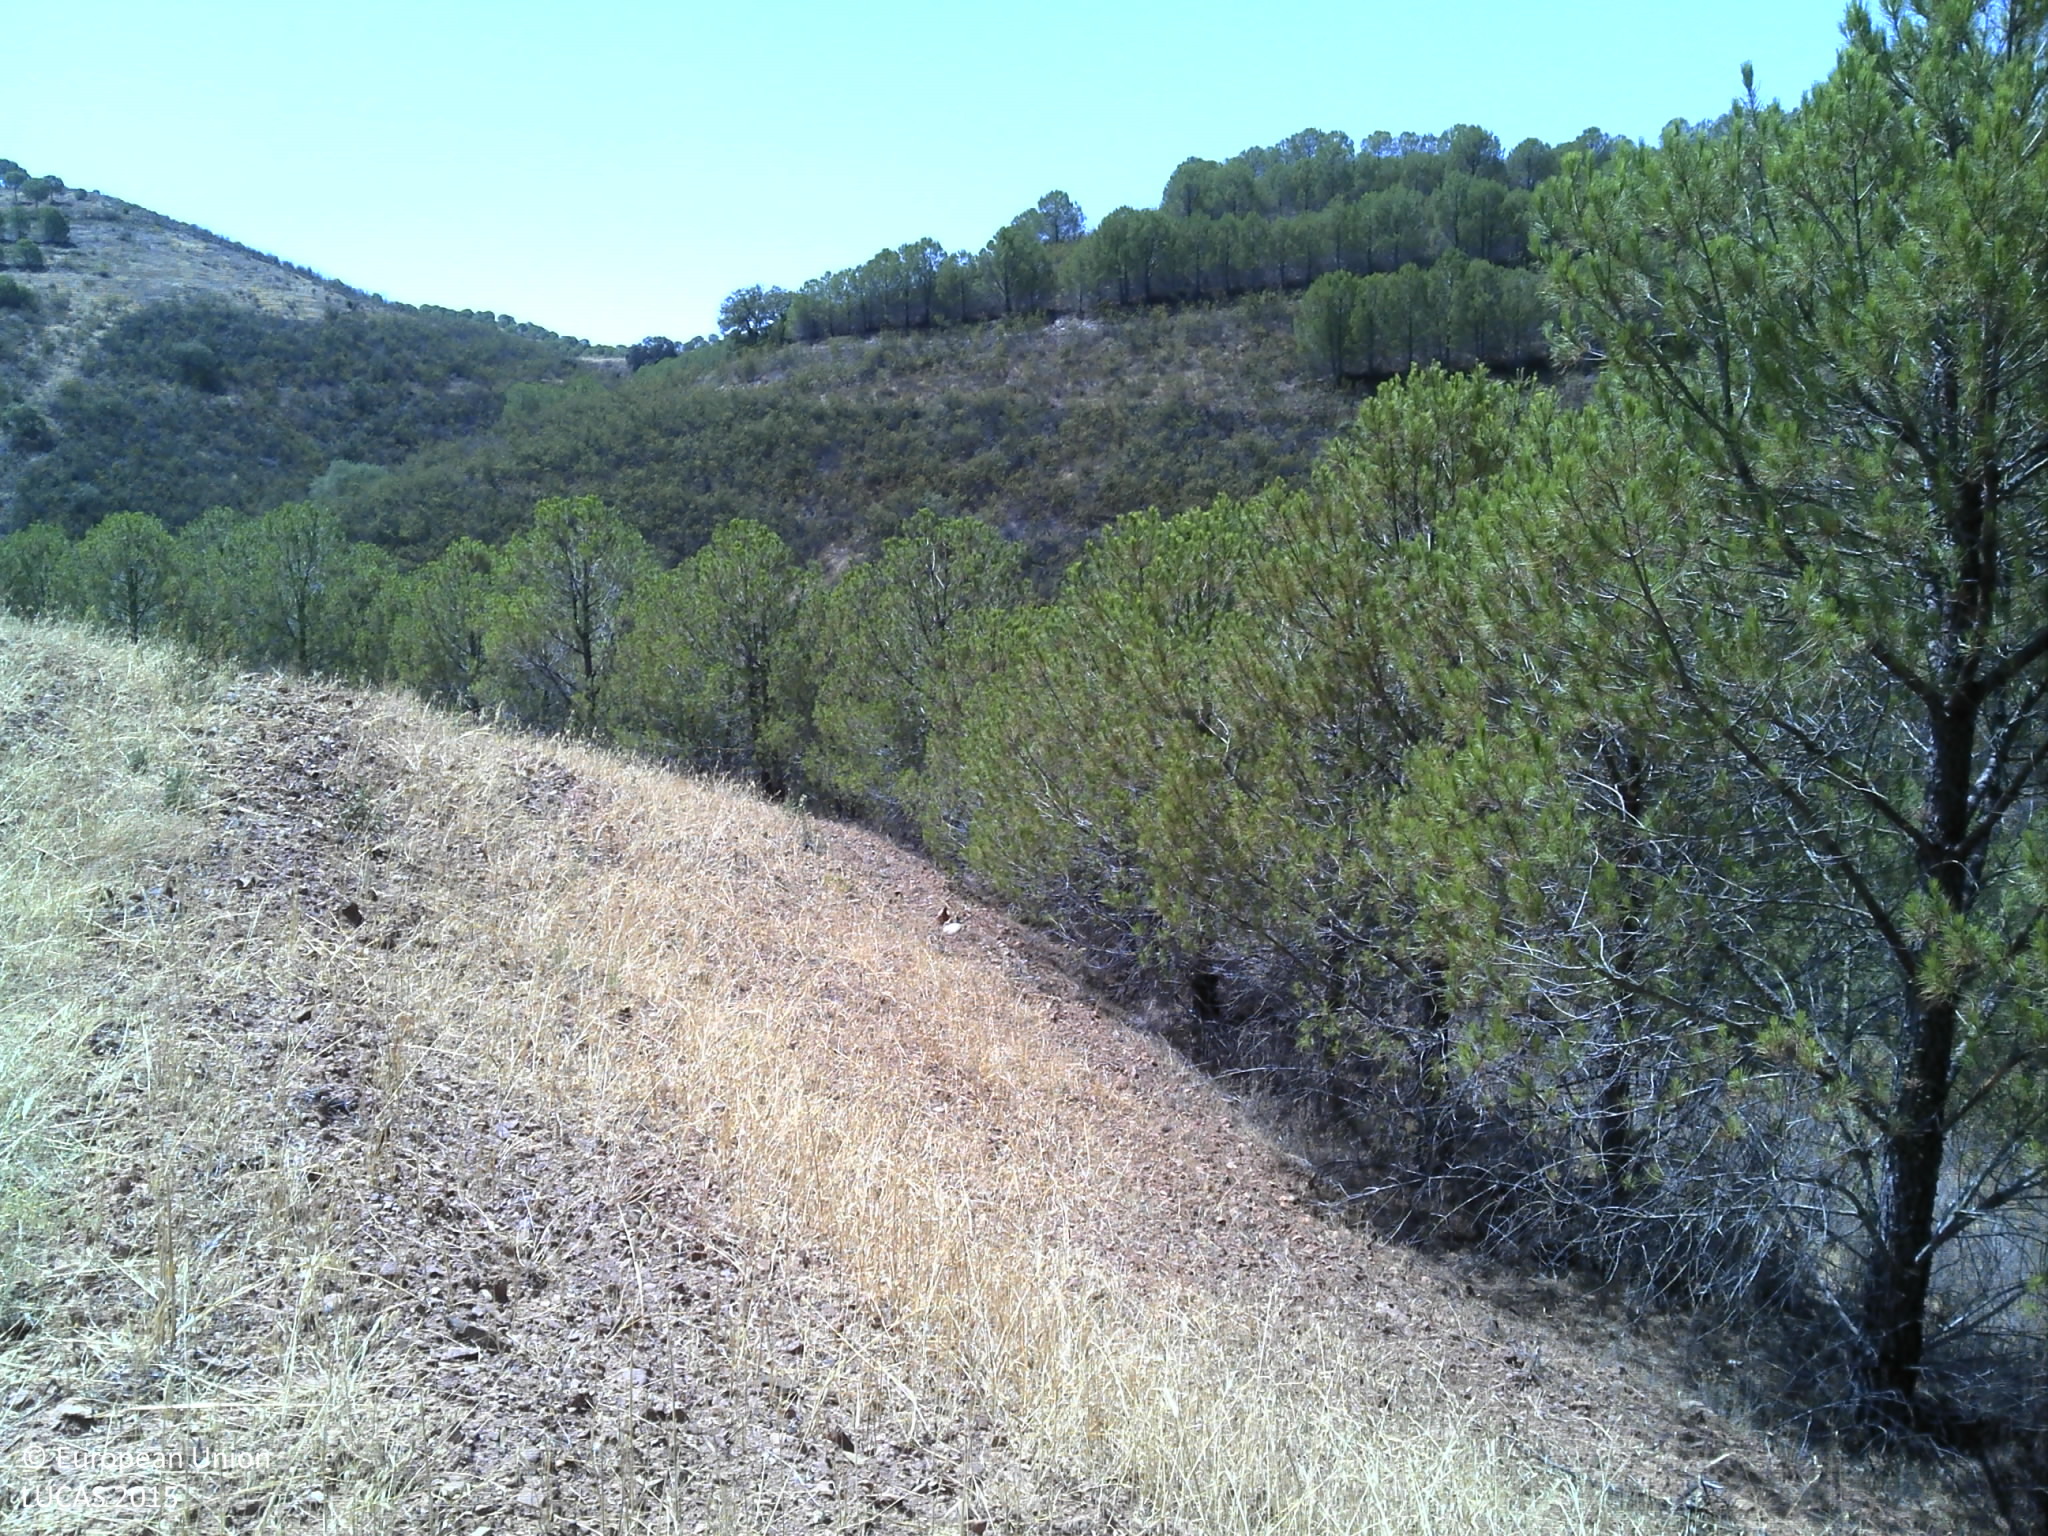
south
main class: Woodland
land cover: Pine dominated coniferous woodland
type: coniferous forest of the mediterranean region
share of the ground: 10 - 25 %
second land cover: Oats
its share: < 10 %
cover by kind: coniferous forest trees 85 %, herbaceous plants 10 %, unconsolidated bare surface 5 %
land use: Forestry
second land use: Agriculture (excluding fallow land and kitchen gardens)
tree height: < 5 m
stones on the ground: < 10 %
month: July
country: PT
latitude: 37.4259
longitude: -7.8820
